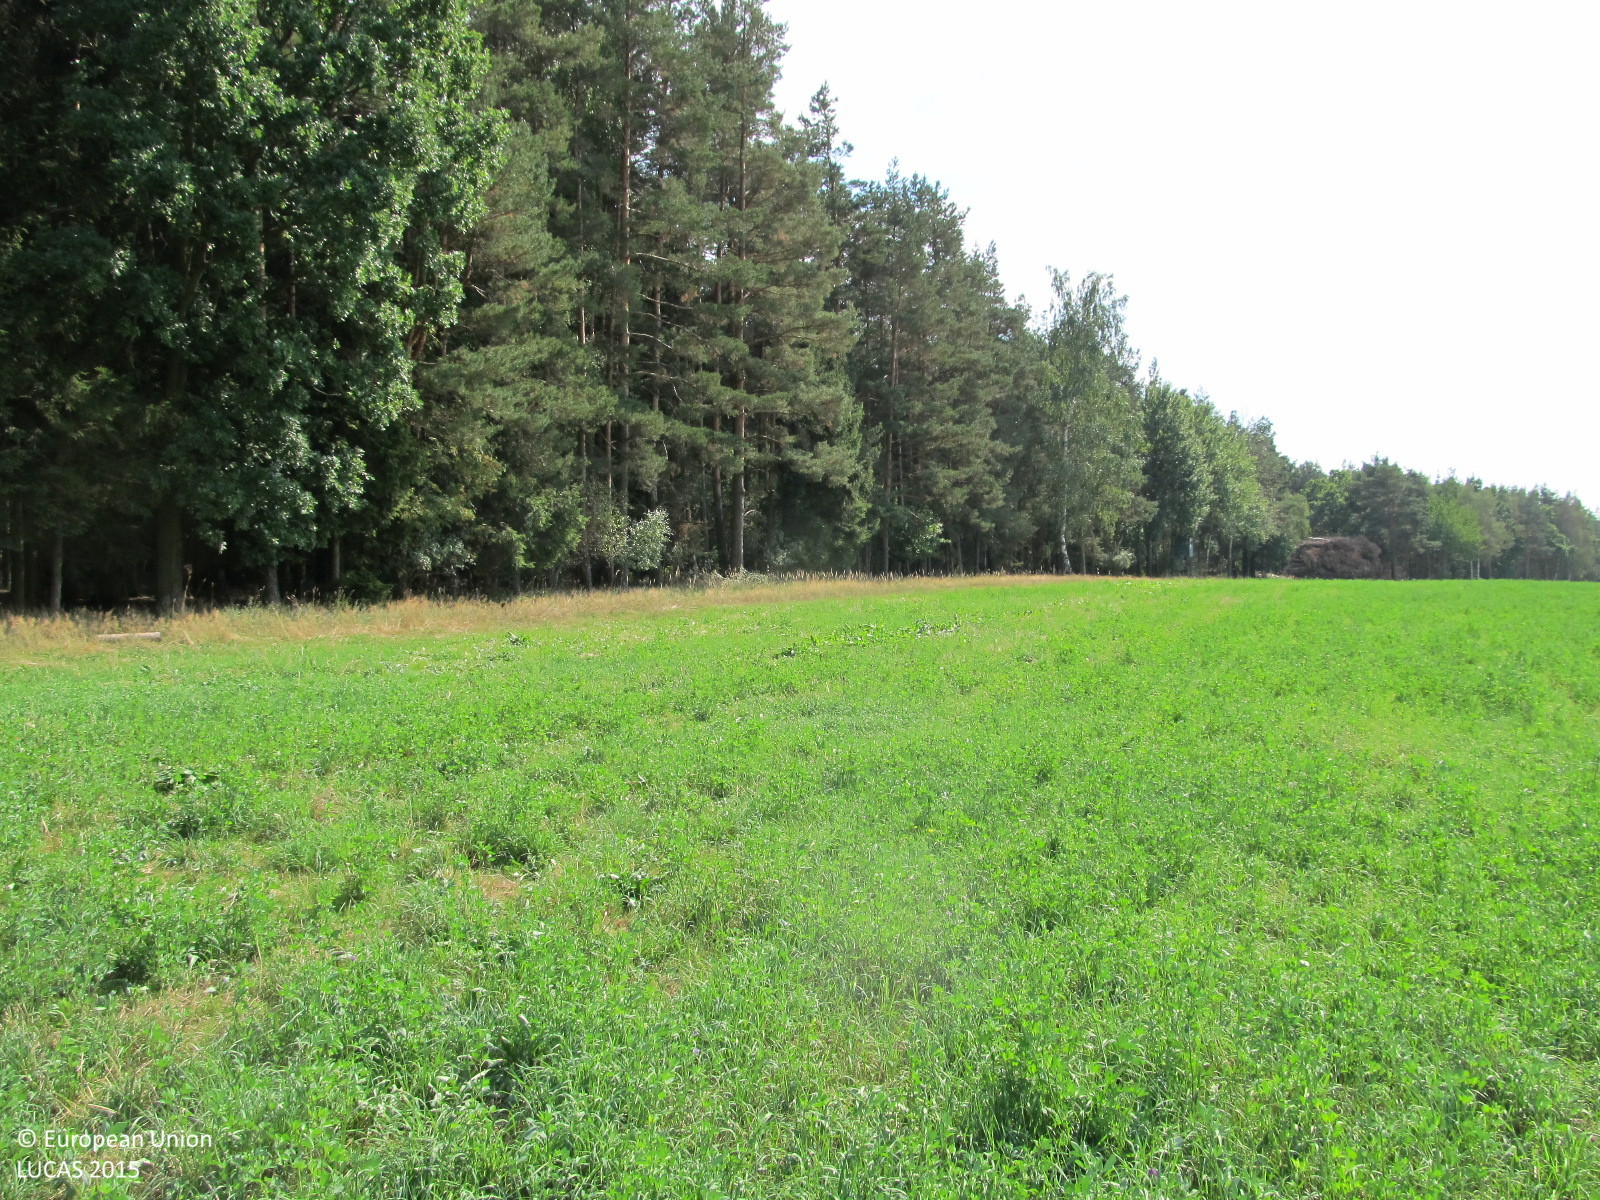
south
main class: Grassland
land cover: Grassland without tree/shrub cover
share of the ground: > 75 %
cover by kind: herbaceous plants 100 %
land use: Agriculture (excluding fallow land and kitchen gardens)
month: September
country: AT
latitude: 48.7655
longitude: 15.6223
